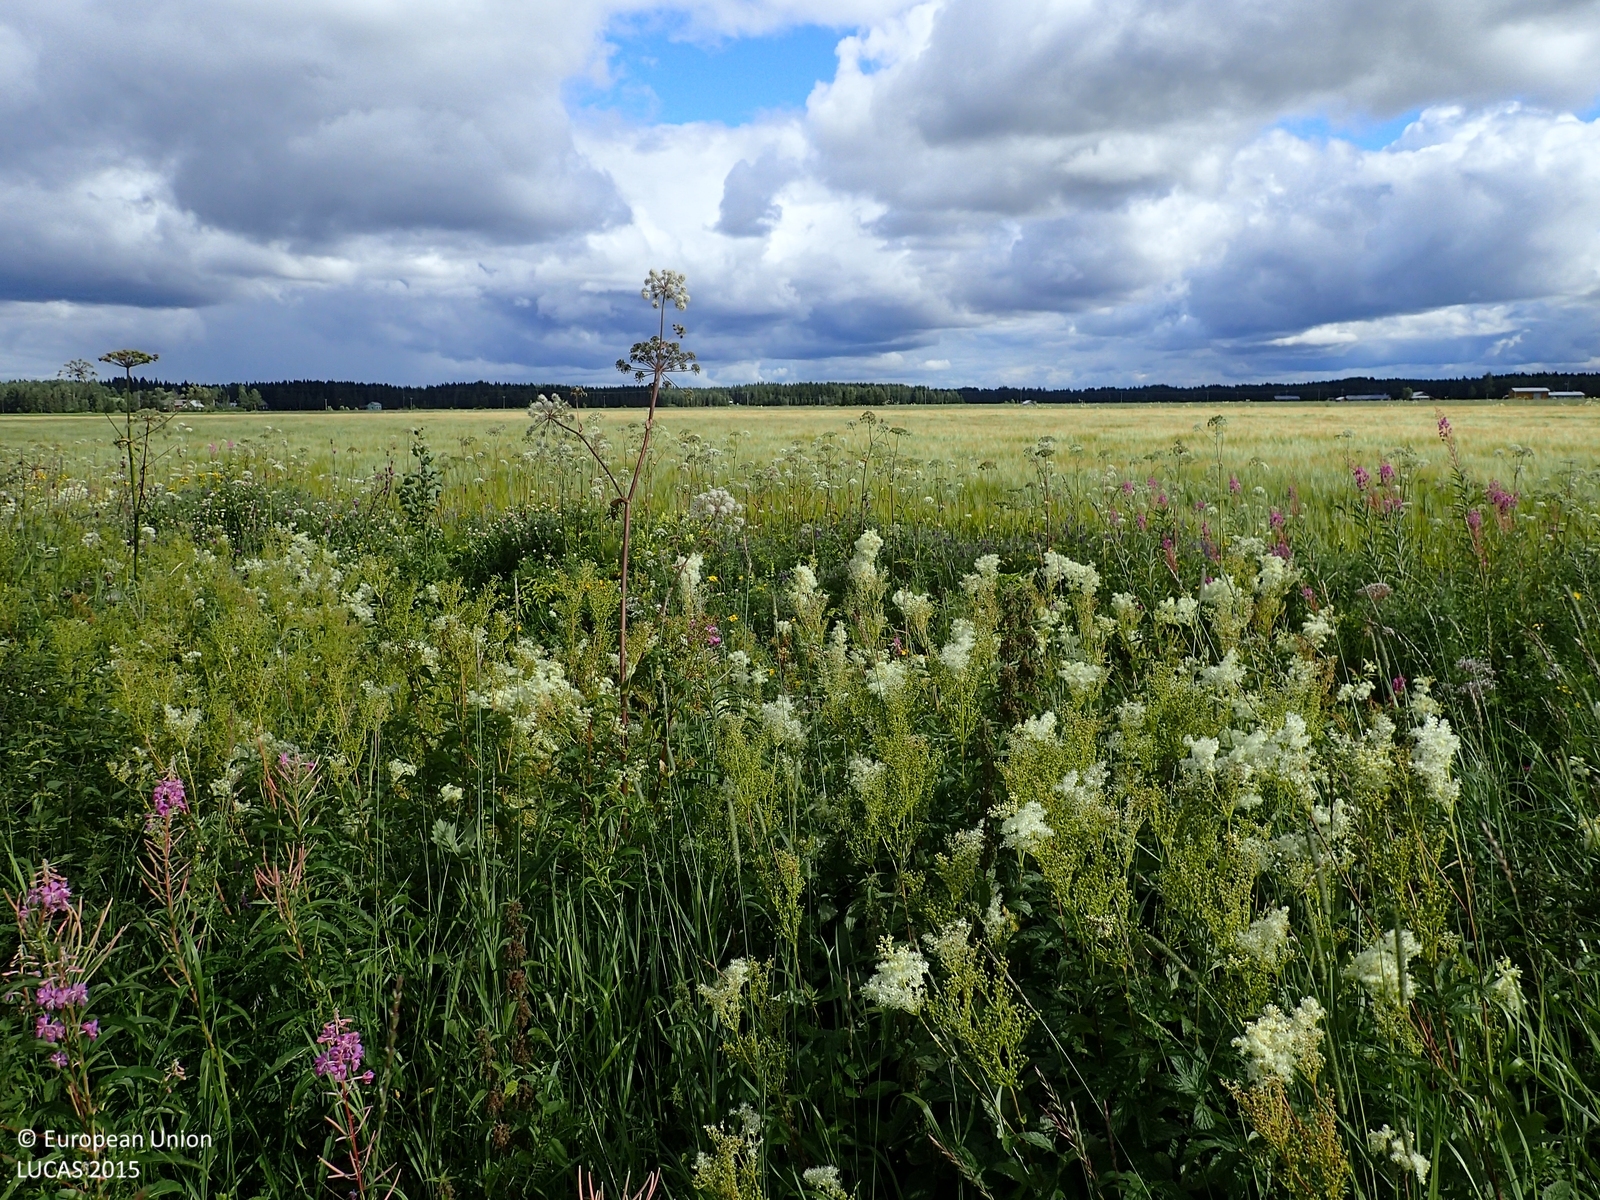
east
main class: Cropland
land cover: Barley
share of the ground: > 75 %
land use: Agriculture (excluding fallow land and kitchen gardens)
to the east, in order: Barley; Shruby margins; Ditches and canals; Shruby margins; Oats; Shruby margins; Ditches and canals; Shruby margins; Barley; Grass margins; Ditches and canals; Grass margins
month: August
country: FI
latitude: 62.6572
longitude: 21.8134
